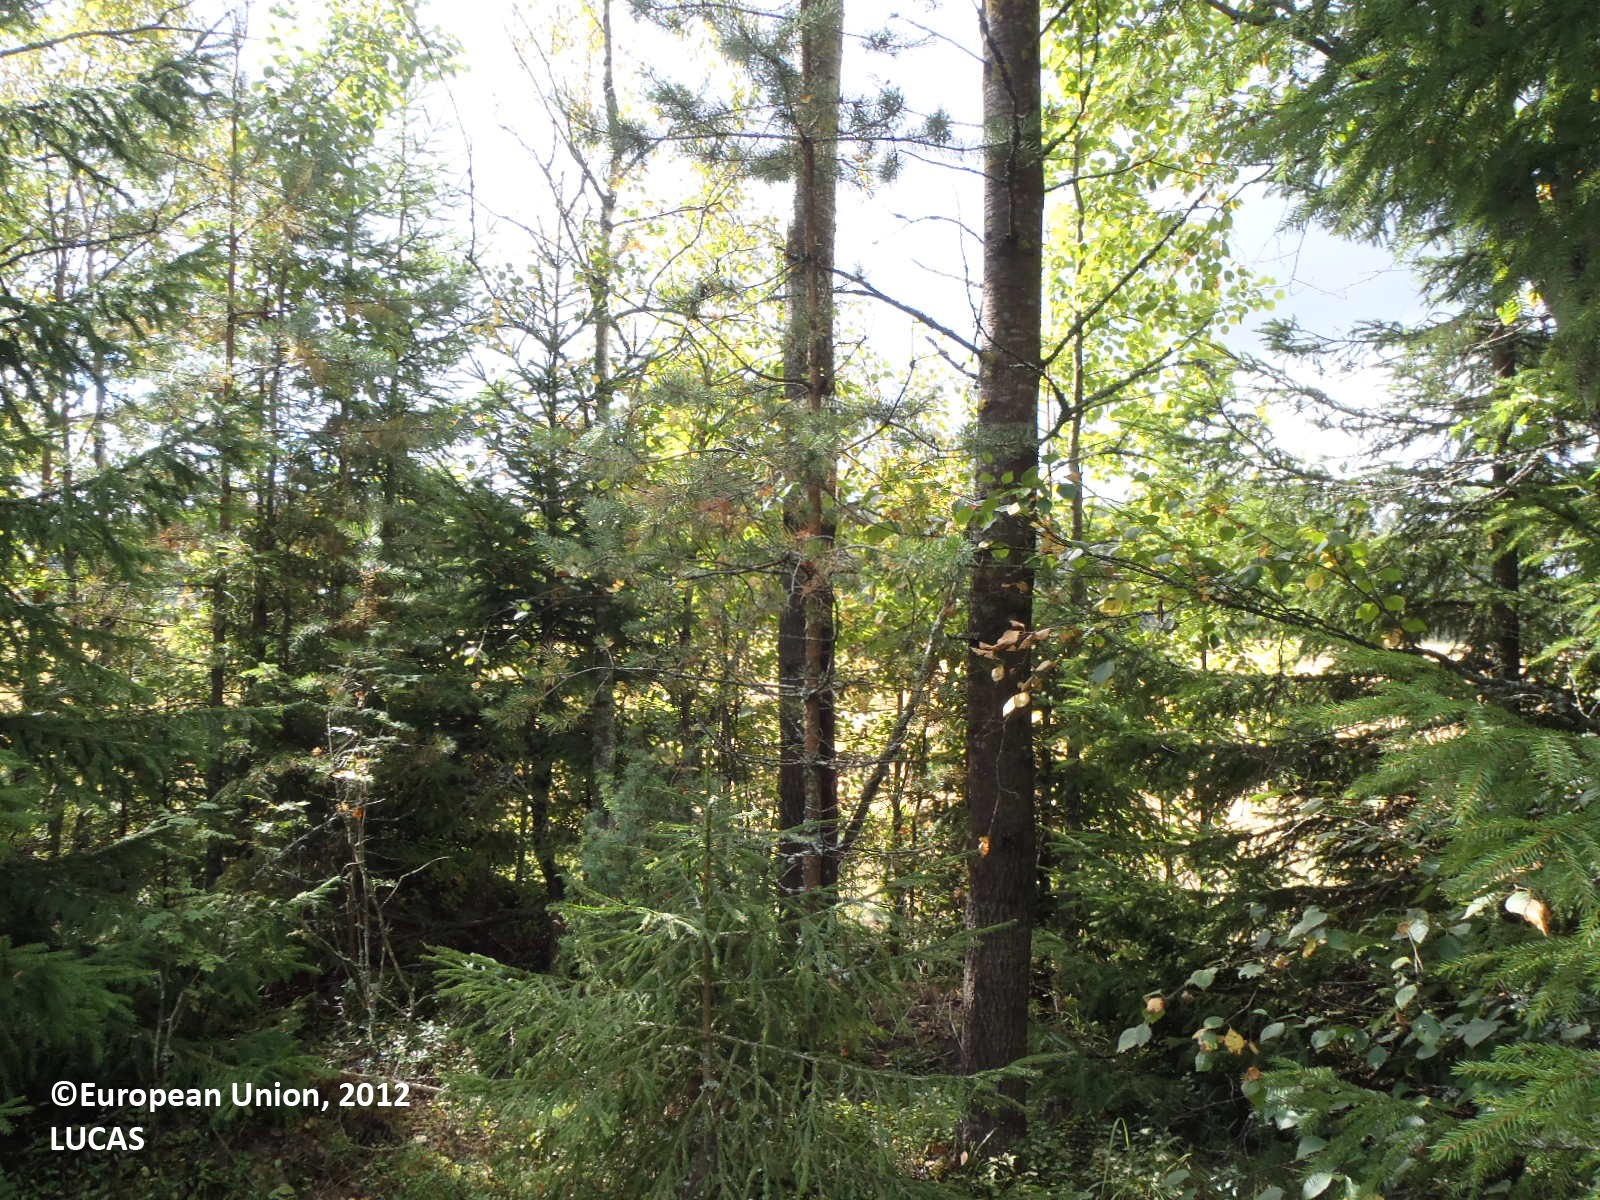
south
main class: Woodland
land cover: Spruce dominated mixed woodland
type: boreal forest
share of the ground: > 75 %
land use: Forestry
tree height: > 5 m
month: August
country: FI
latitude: 60.5316
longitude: 22.3318
